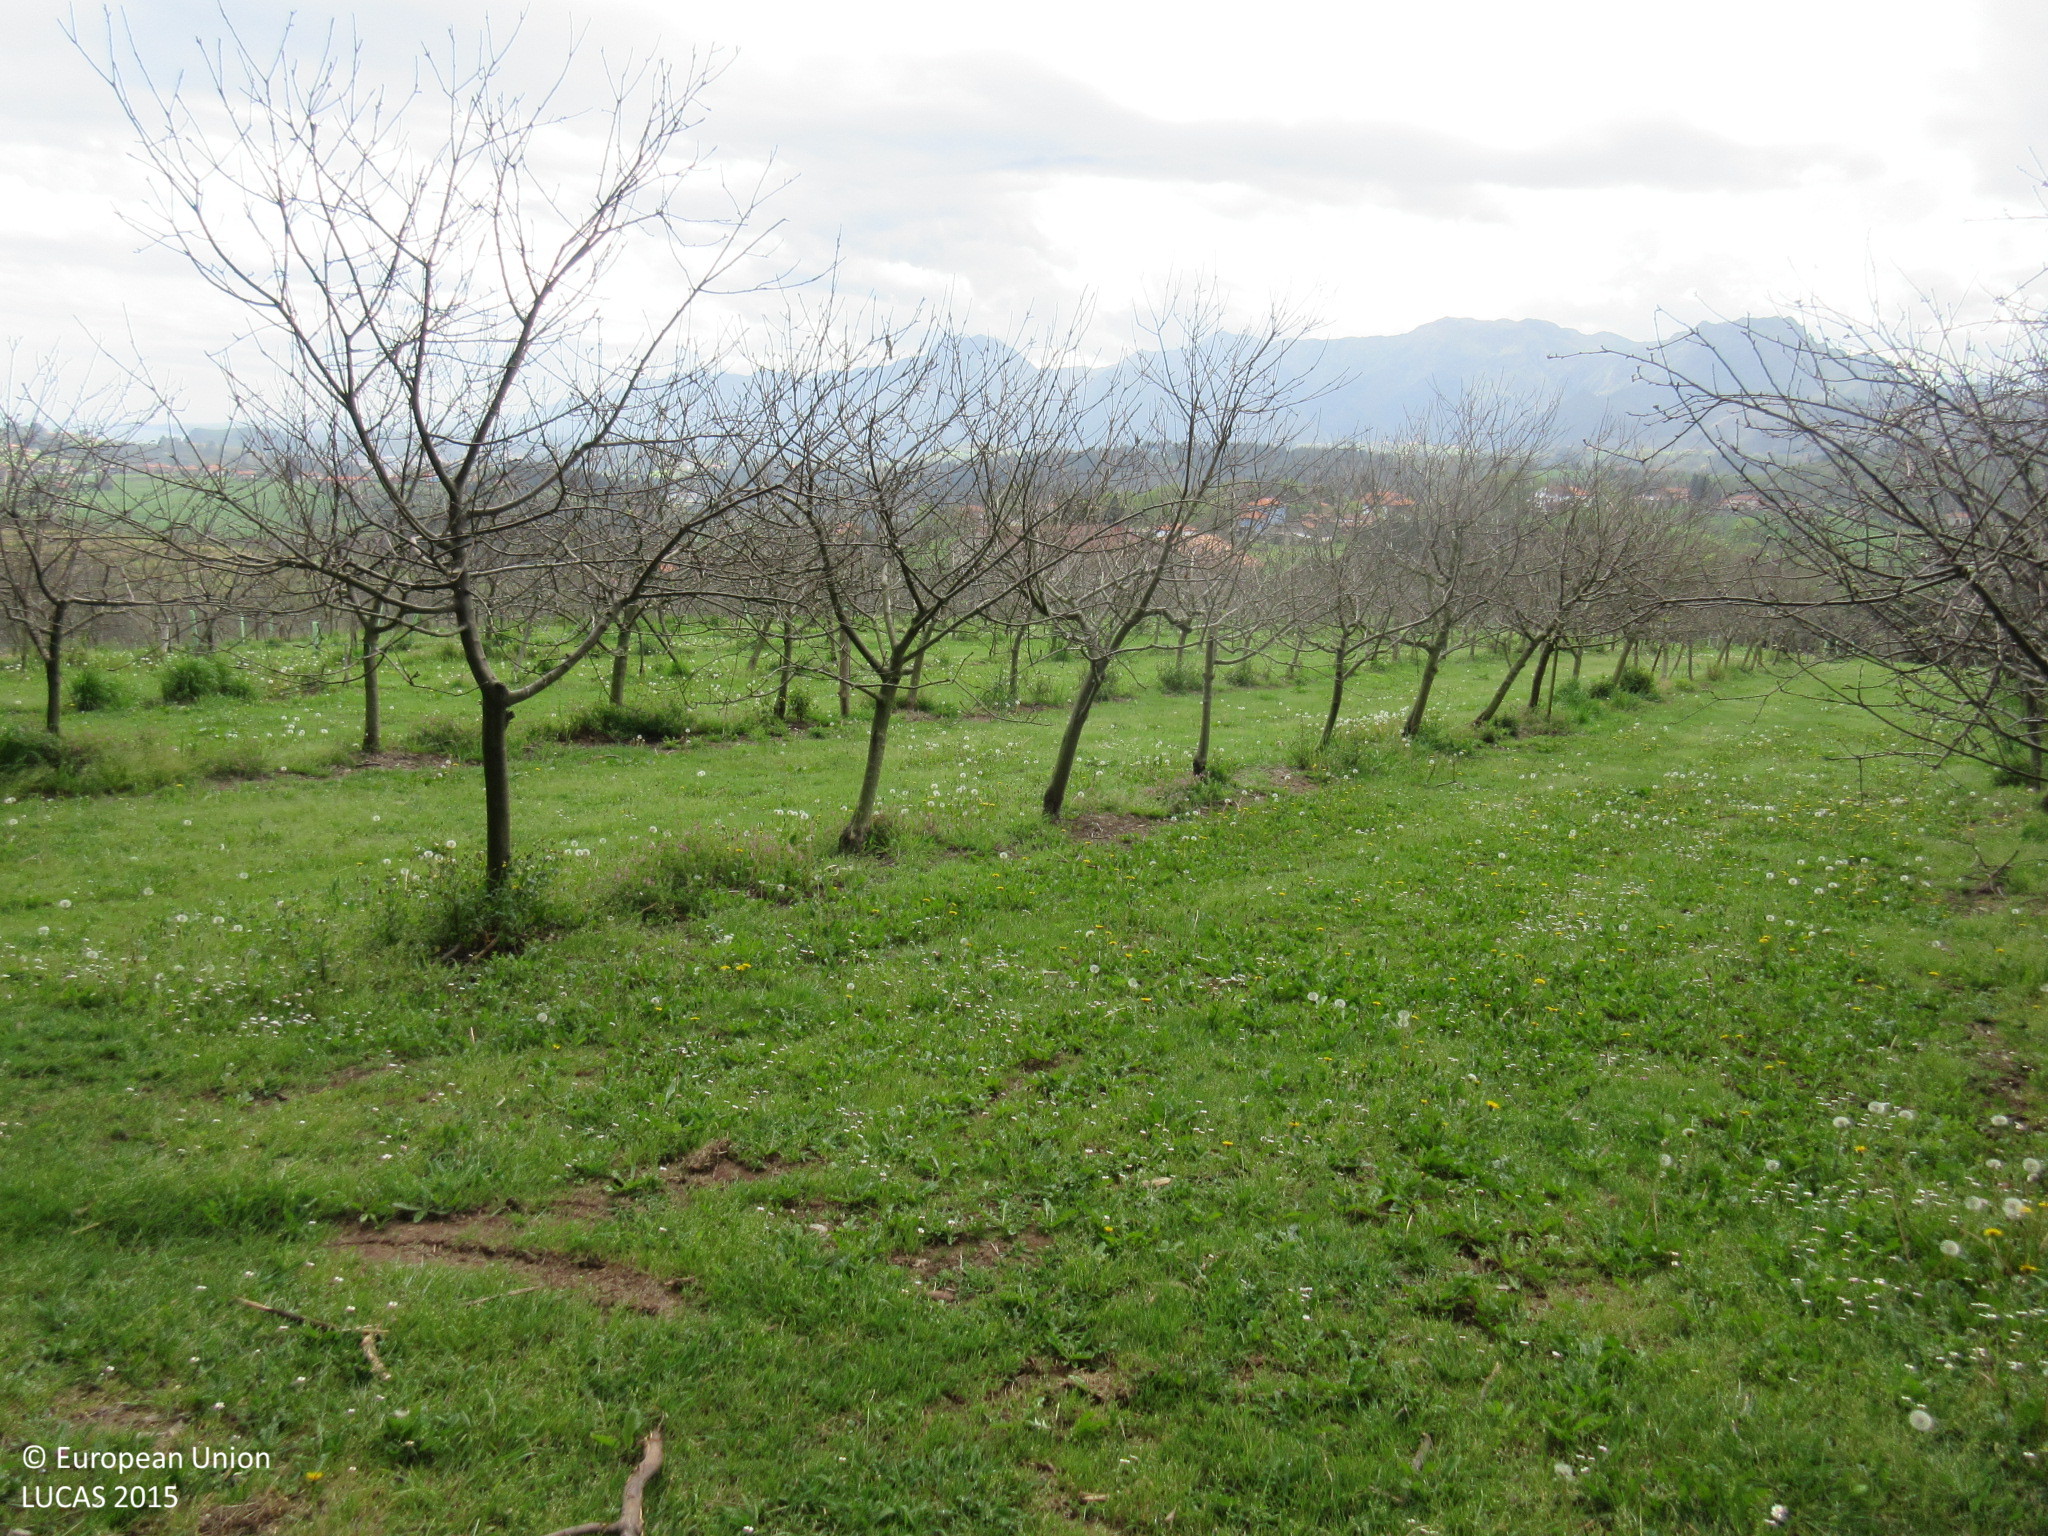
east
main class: Woodland
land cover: Broadleaved woodland
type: exotic forest
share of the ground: > 75 %
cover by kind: broadleaved forest trees 90 %, shrubs 10 %
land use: Forestry
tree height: > 5 m
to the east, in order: Broadleaved woodland; Fences; Apple fruit
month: April
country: ES
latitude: 43.4736
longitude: -5.1180
